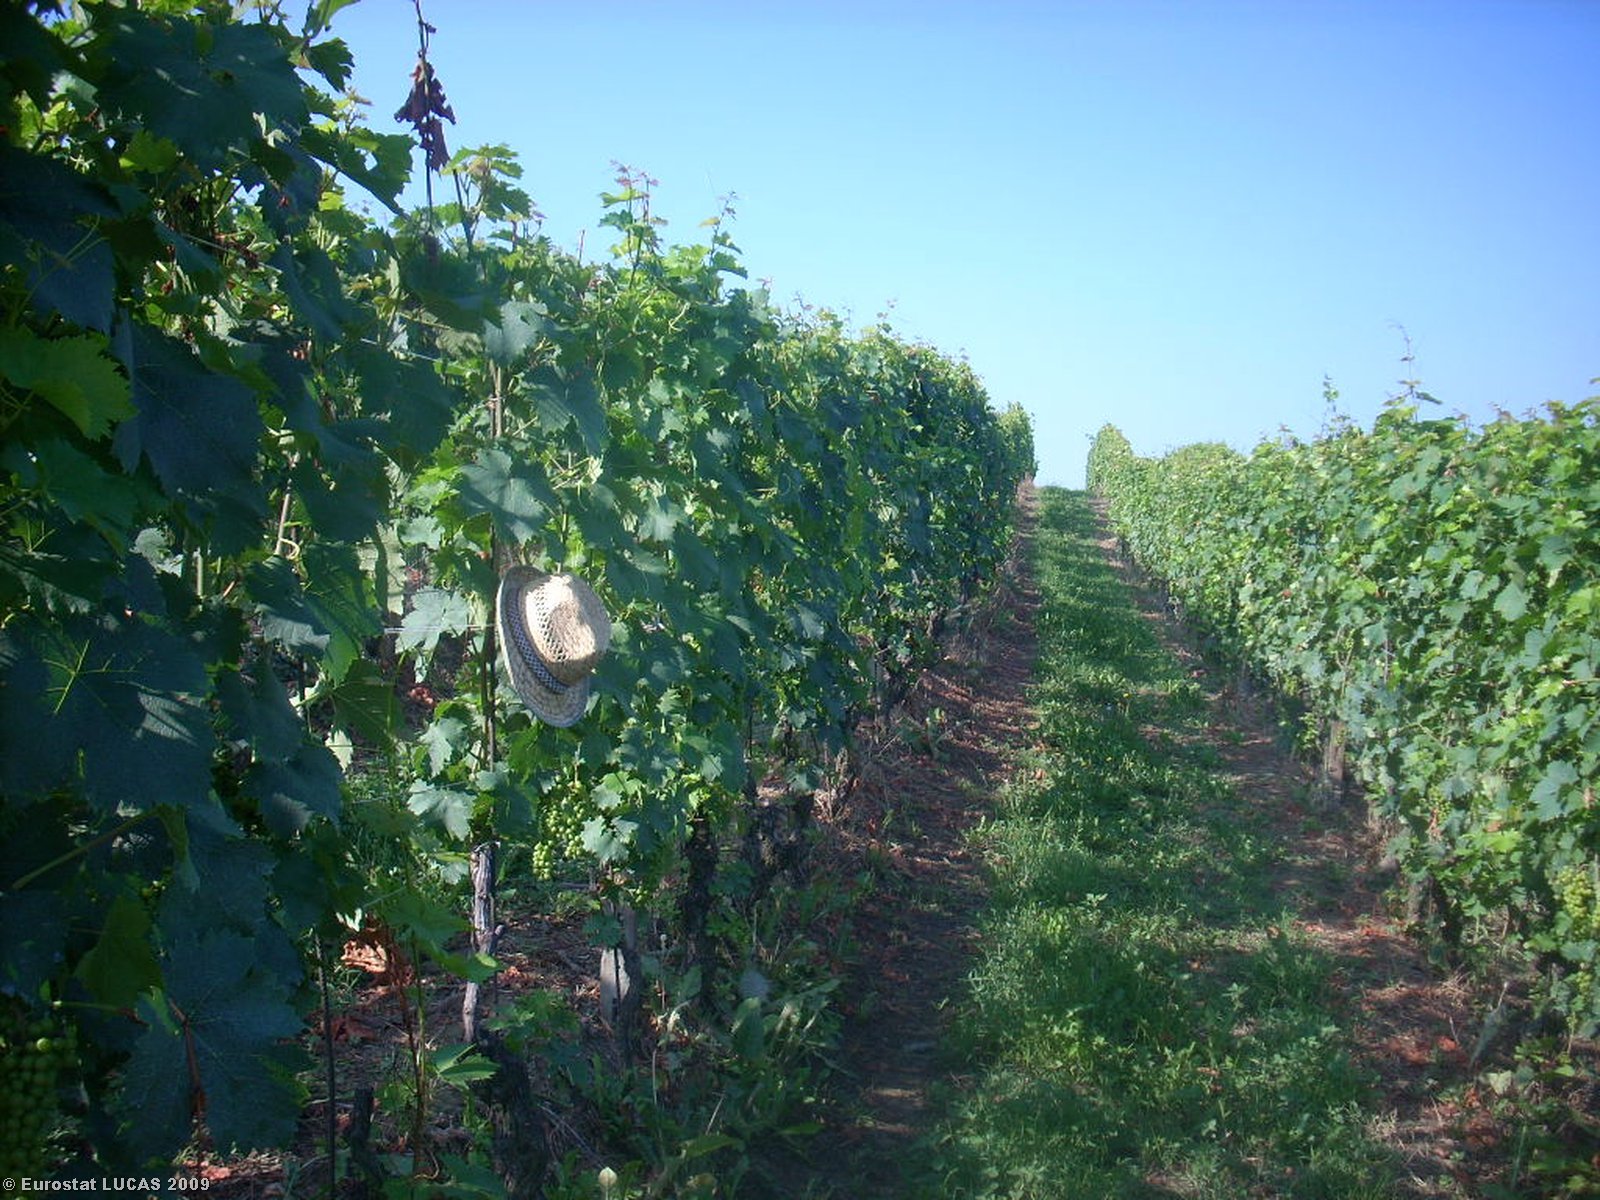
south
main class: Cropland
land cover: Vineyards
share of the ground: 10 - 25 %
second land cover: Grassland with sparse tree/shrub cover
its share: > 75 %
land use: Agriculture (excluding fallow land and kitchen gardens)
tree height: < 5 m
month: July
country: IT
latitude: 44.7300
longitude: 8.0972
